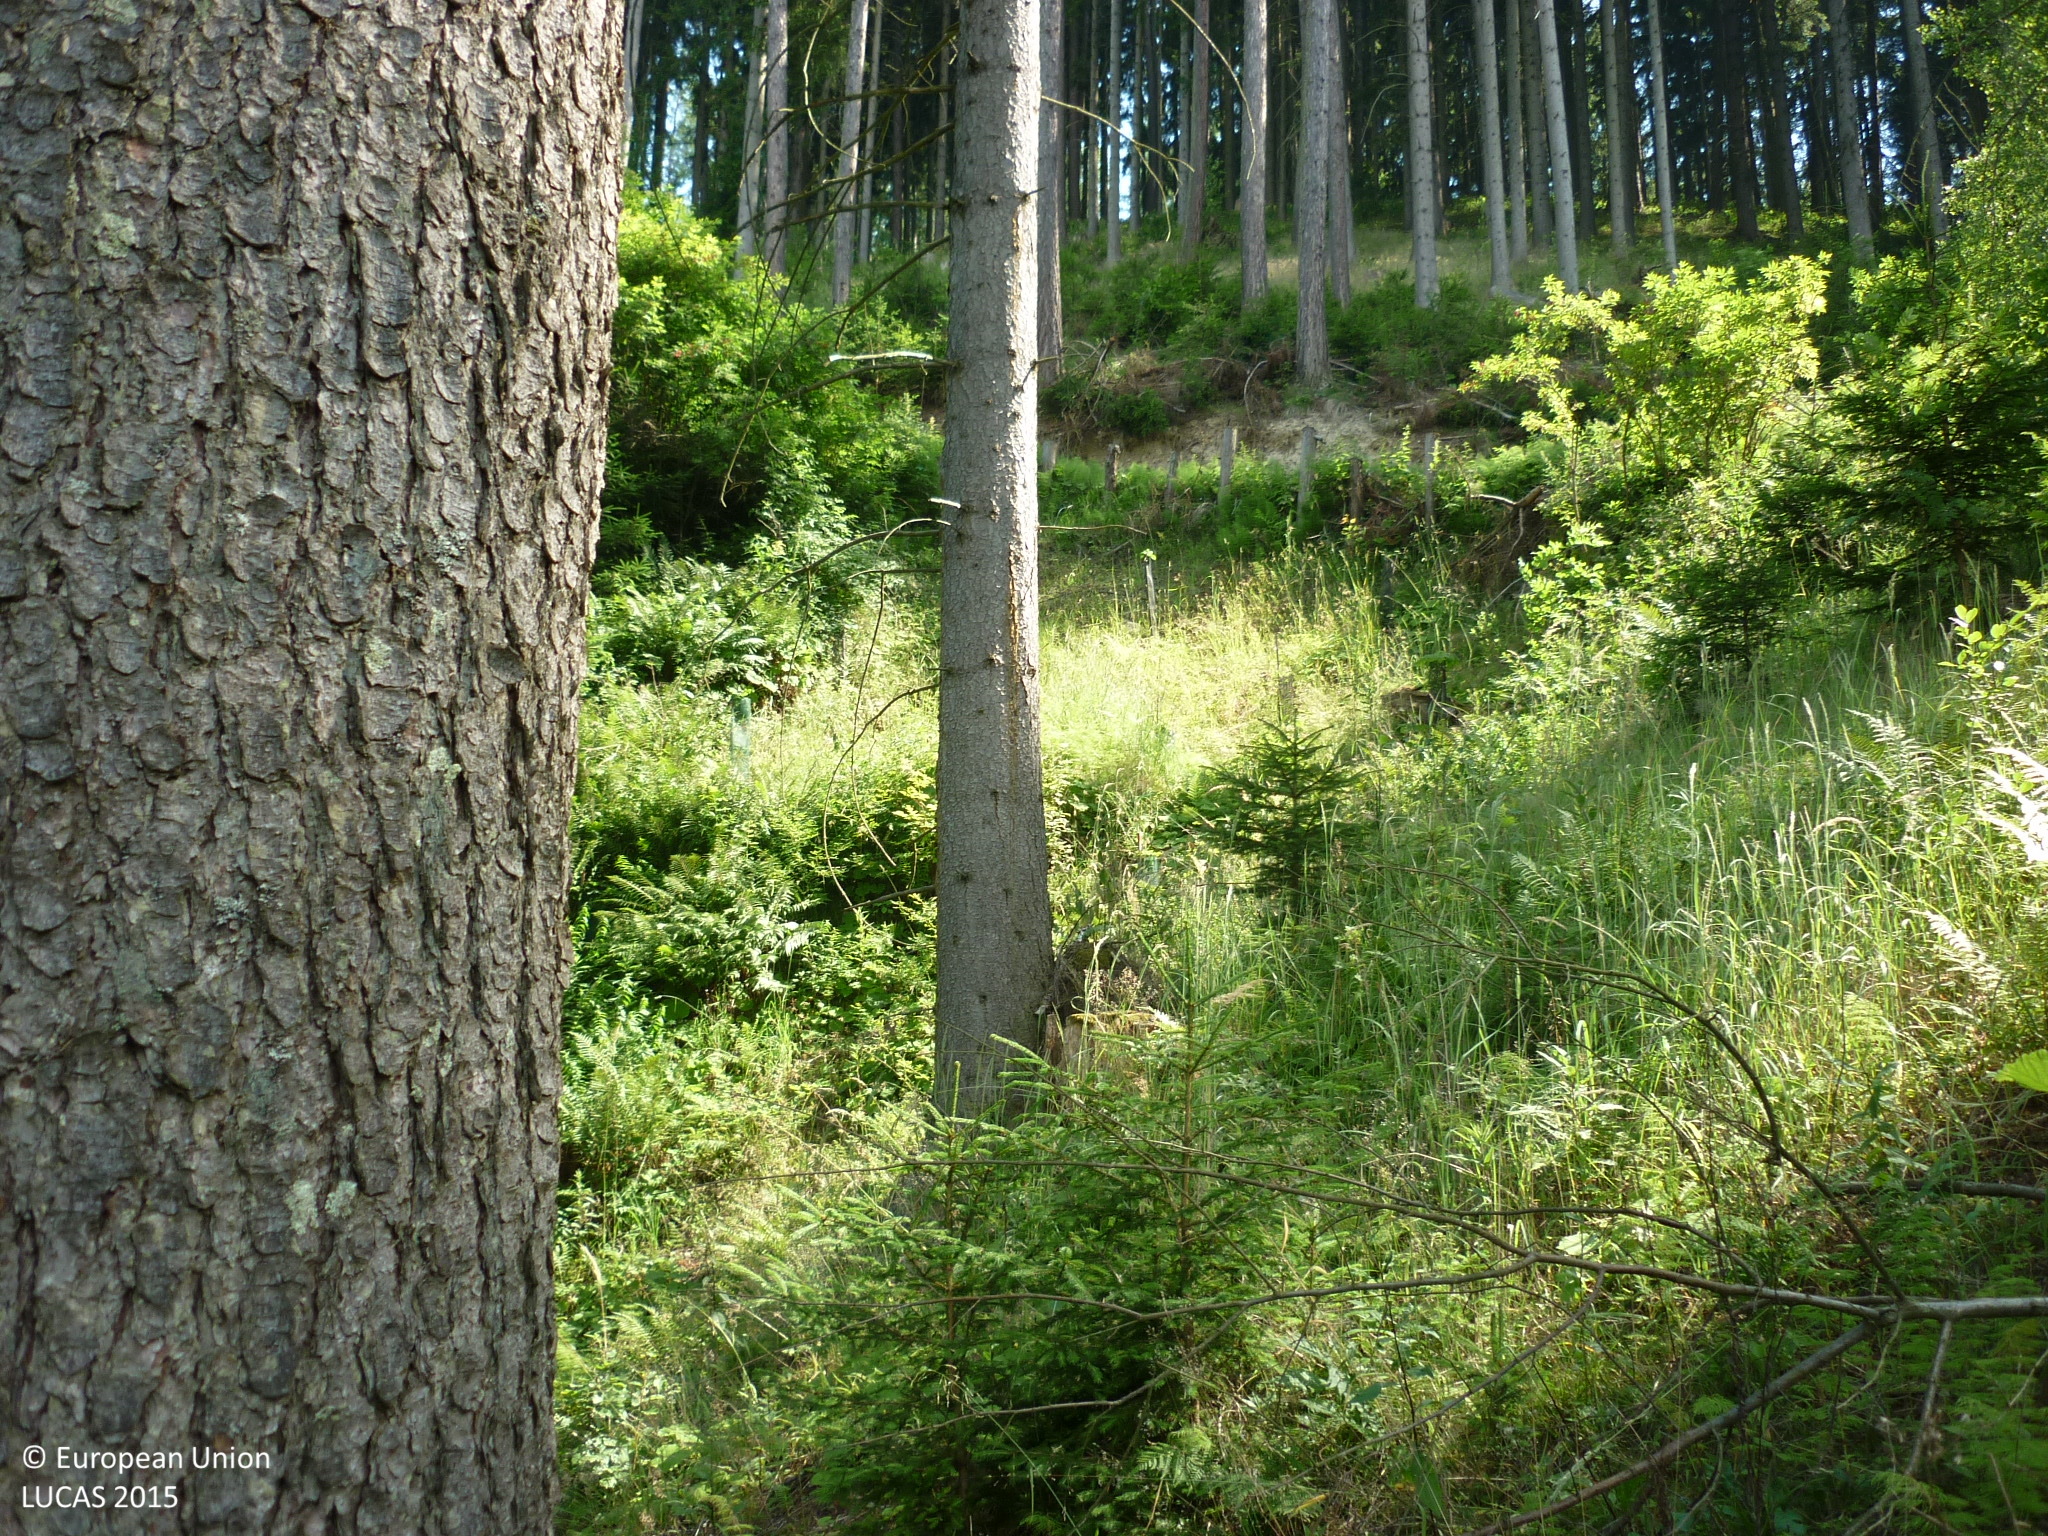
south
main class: Woodland
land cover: Spruce dominated coniferous woodland
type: alpine coniferous forest
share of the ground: 50 - 75 %
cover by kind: coniferous forest trees 40 %, herbaceous plants 30 %, shrubs 20 %, broadleaved forest trees 10 %
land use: Forestry
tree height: > 5 m
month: July
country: AT
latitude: 47.1964
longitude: 14.8697
